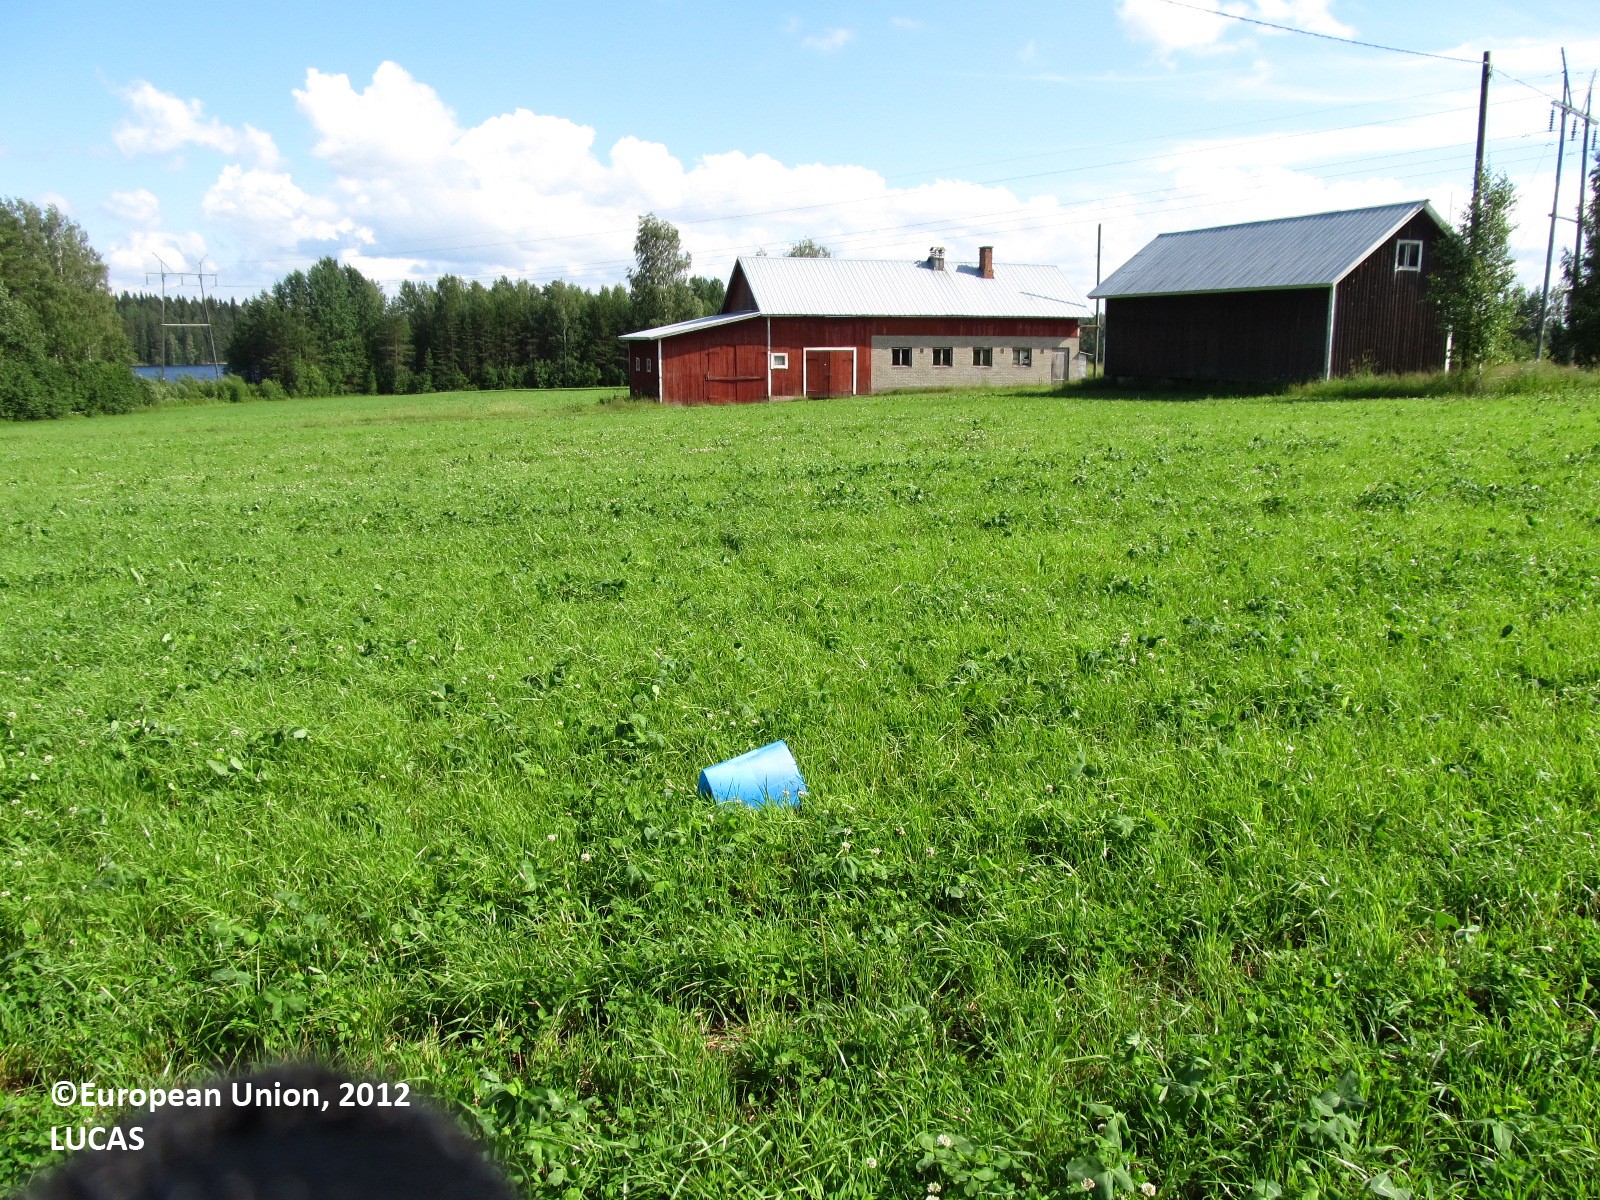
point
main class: Grassland
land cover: Spontaneously vegetated surfaces
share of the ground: > 75 %
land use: Agriculture (excluding fallow land and kitchen gardens)
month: July
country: FI
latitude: 61.9230
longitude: 28.4318
